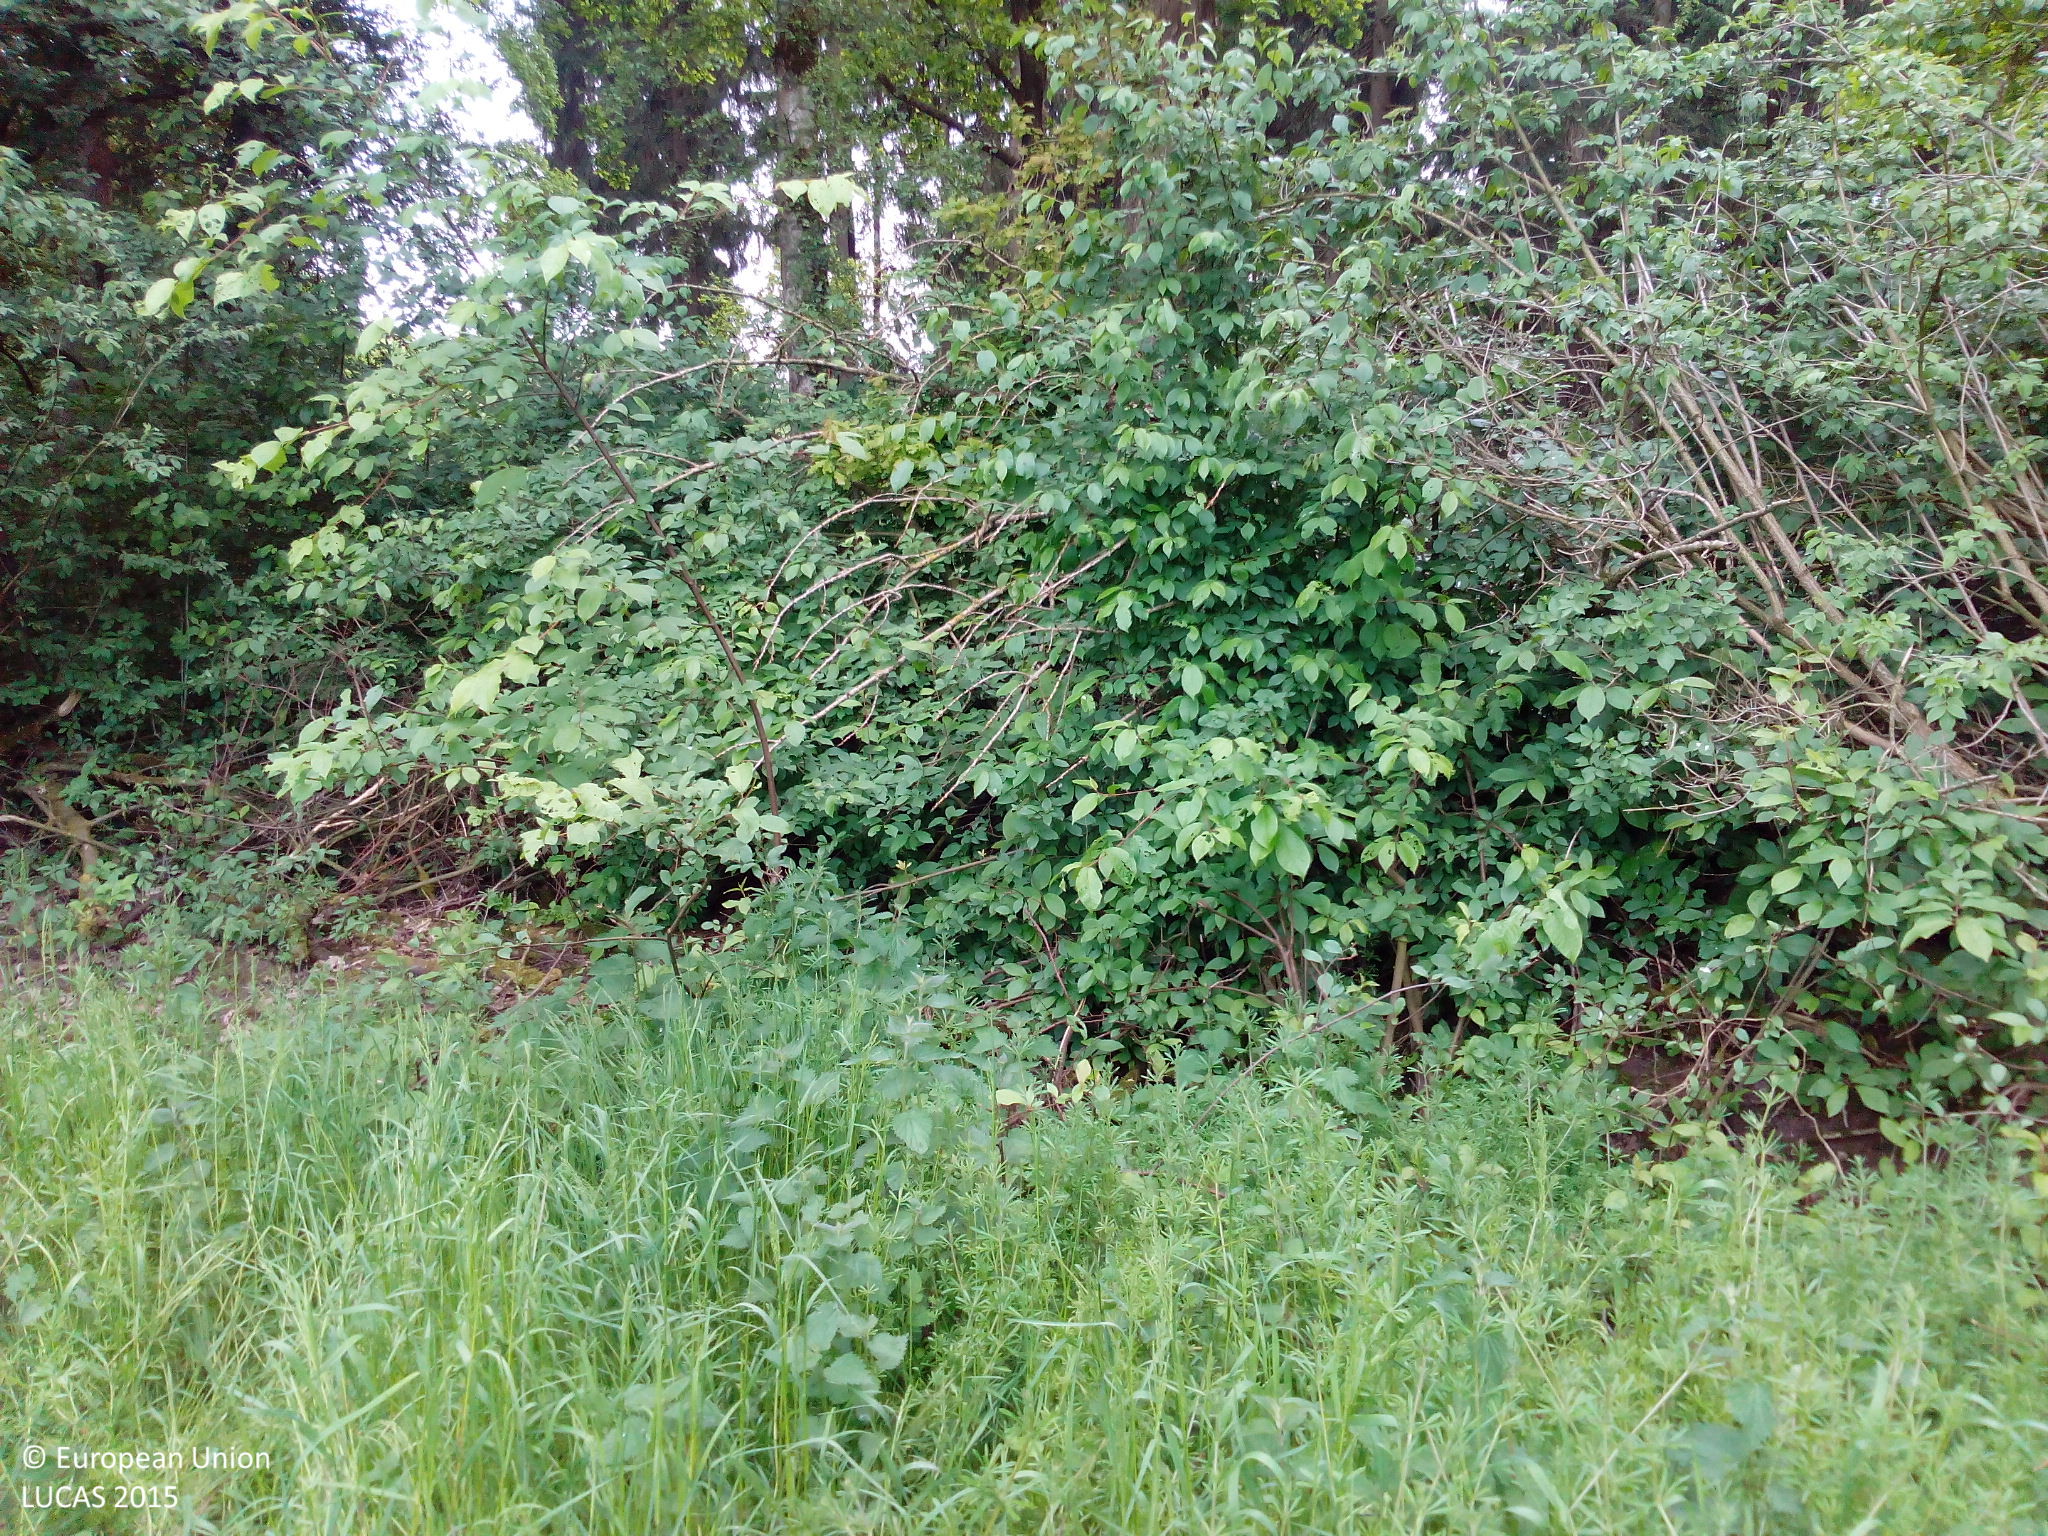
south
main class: Cropland
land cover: Barley
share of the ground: > 75 %
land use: Agriculture (excluding fallow land and kitchen gardens)
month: May
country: DE
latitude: 52.0191
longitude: 8.0040
